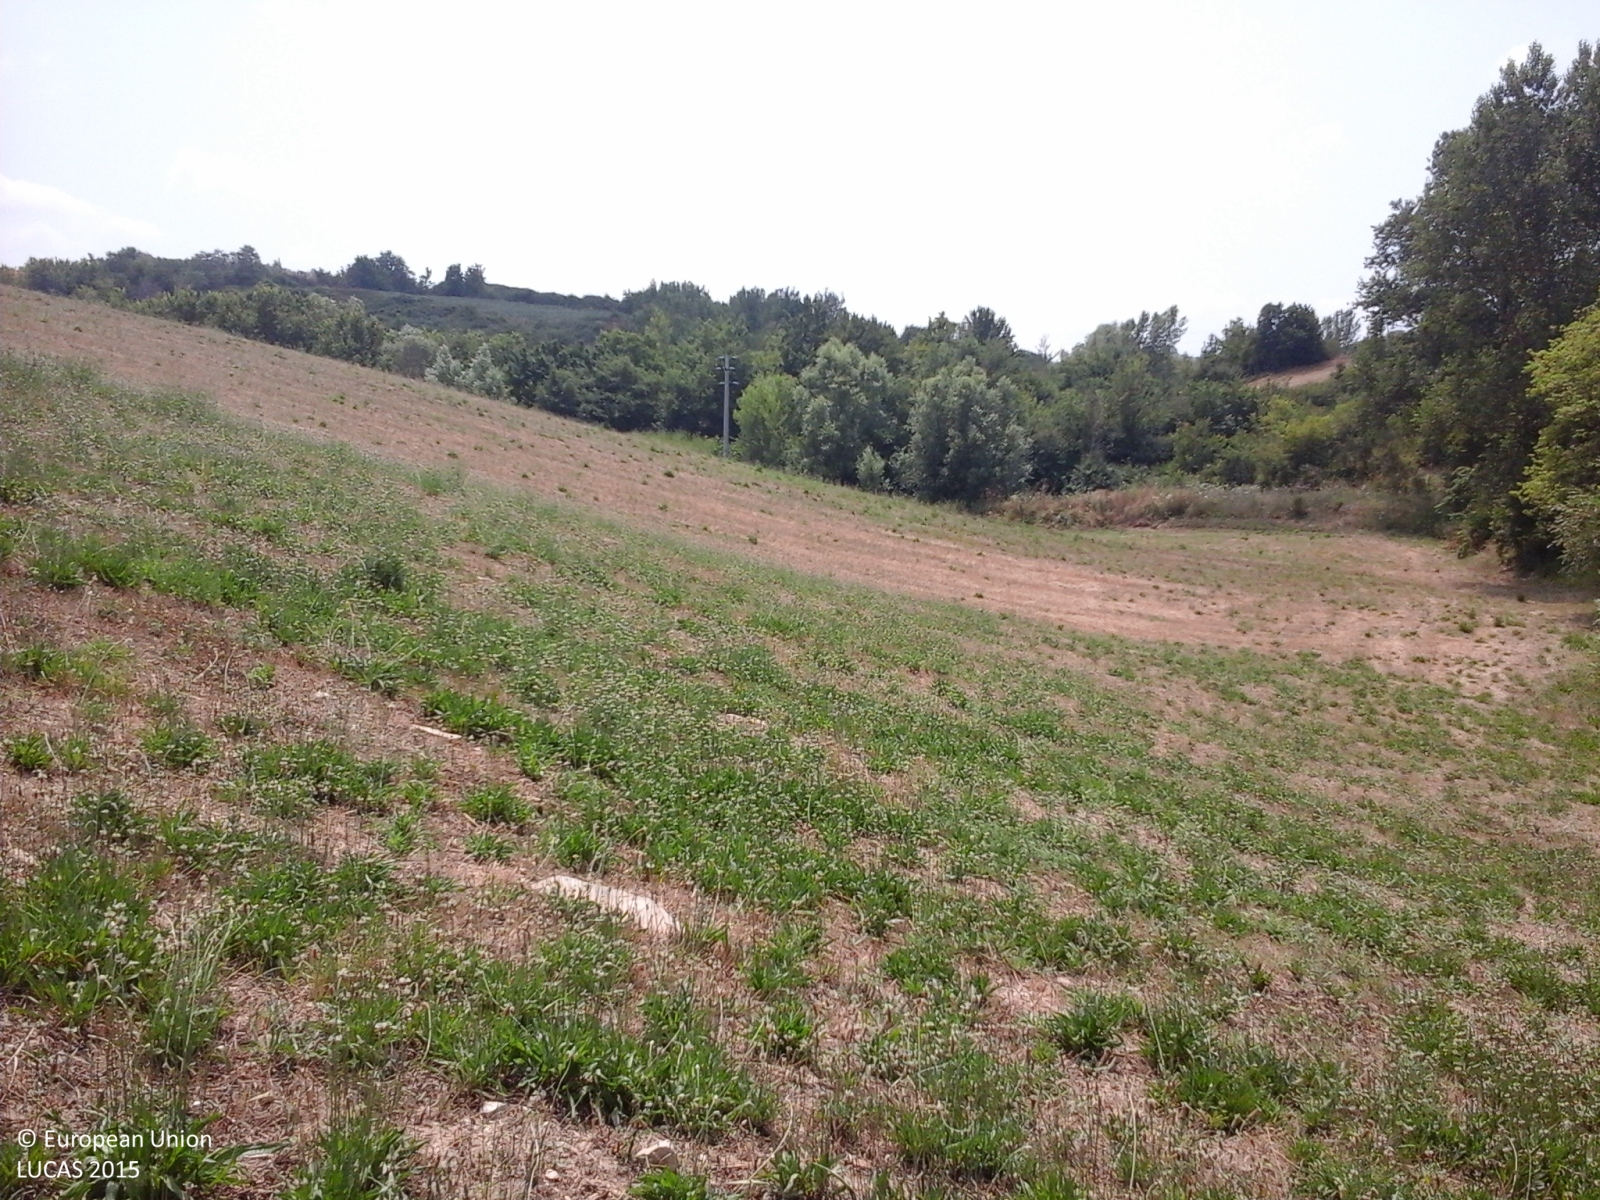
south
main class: Grassland
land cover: Spontaneously vegetated surfaces
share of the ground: > 75 %
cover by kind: herbaceous plants 90 %, consolidated bare surface 10 %
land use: Agriculture (excluding fallow land and kitchen gardens)
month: July
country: IT
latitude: 40.9515
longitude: 15.0769
